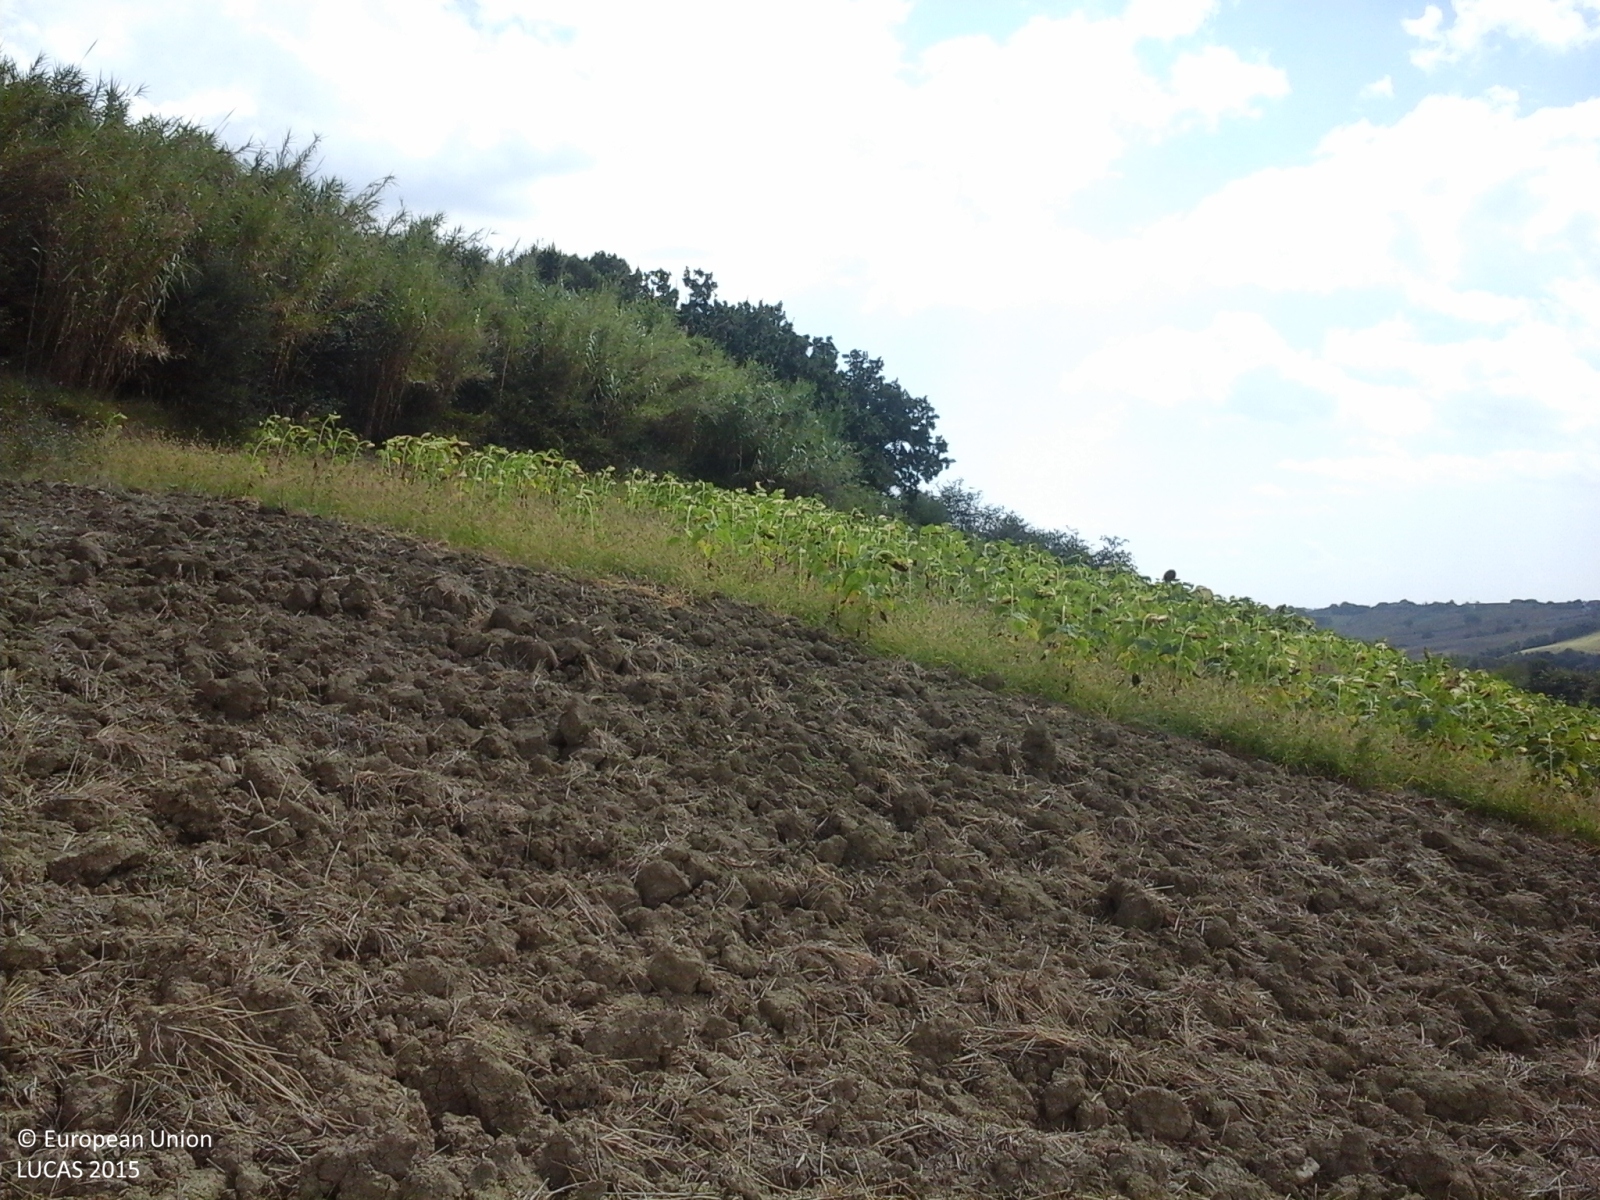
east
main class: Cropland
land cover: Durum wheat
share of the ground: < 10 %
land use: Agriculture (excluding fallow land and kitchen gardens)
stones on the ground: 10 - 25 %
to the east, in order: Durum wheat; Sunflower; Shrubland with sparse tree cover; Sunflower; Broadleaved woodland; Shrubland without tree cover
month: August
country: IT
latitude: 43.3972
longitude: 13.2389
